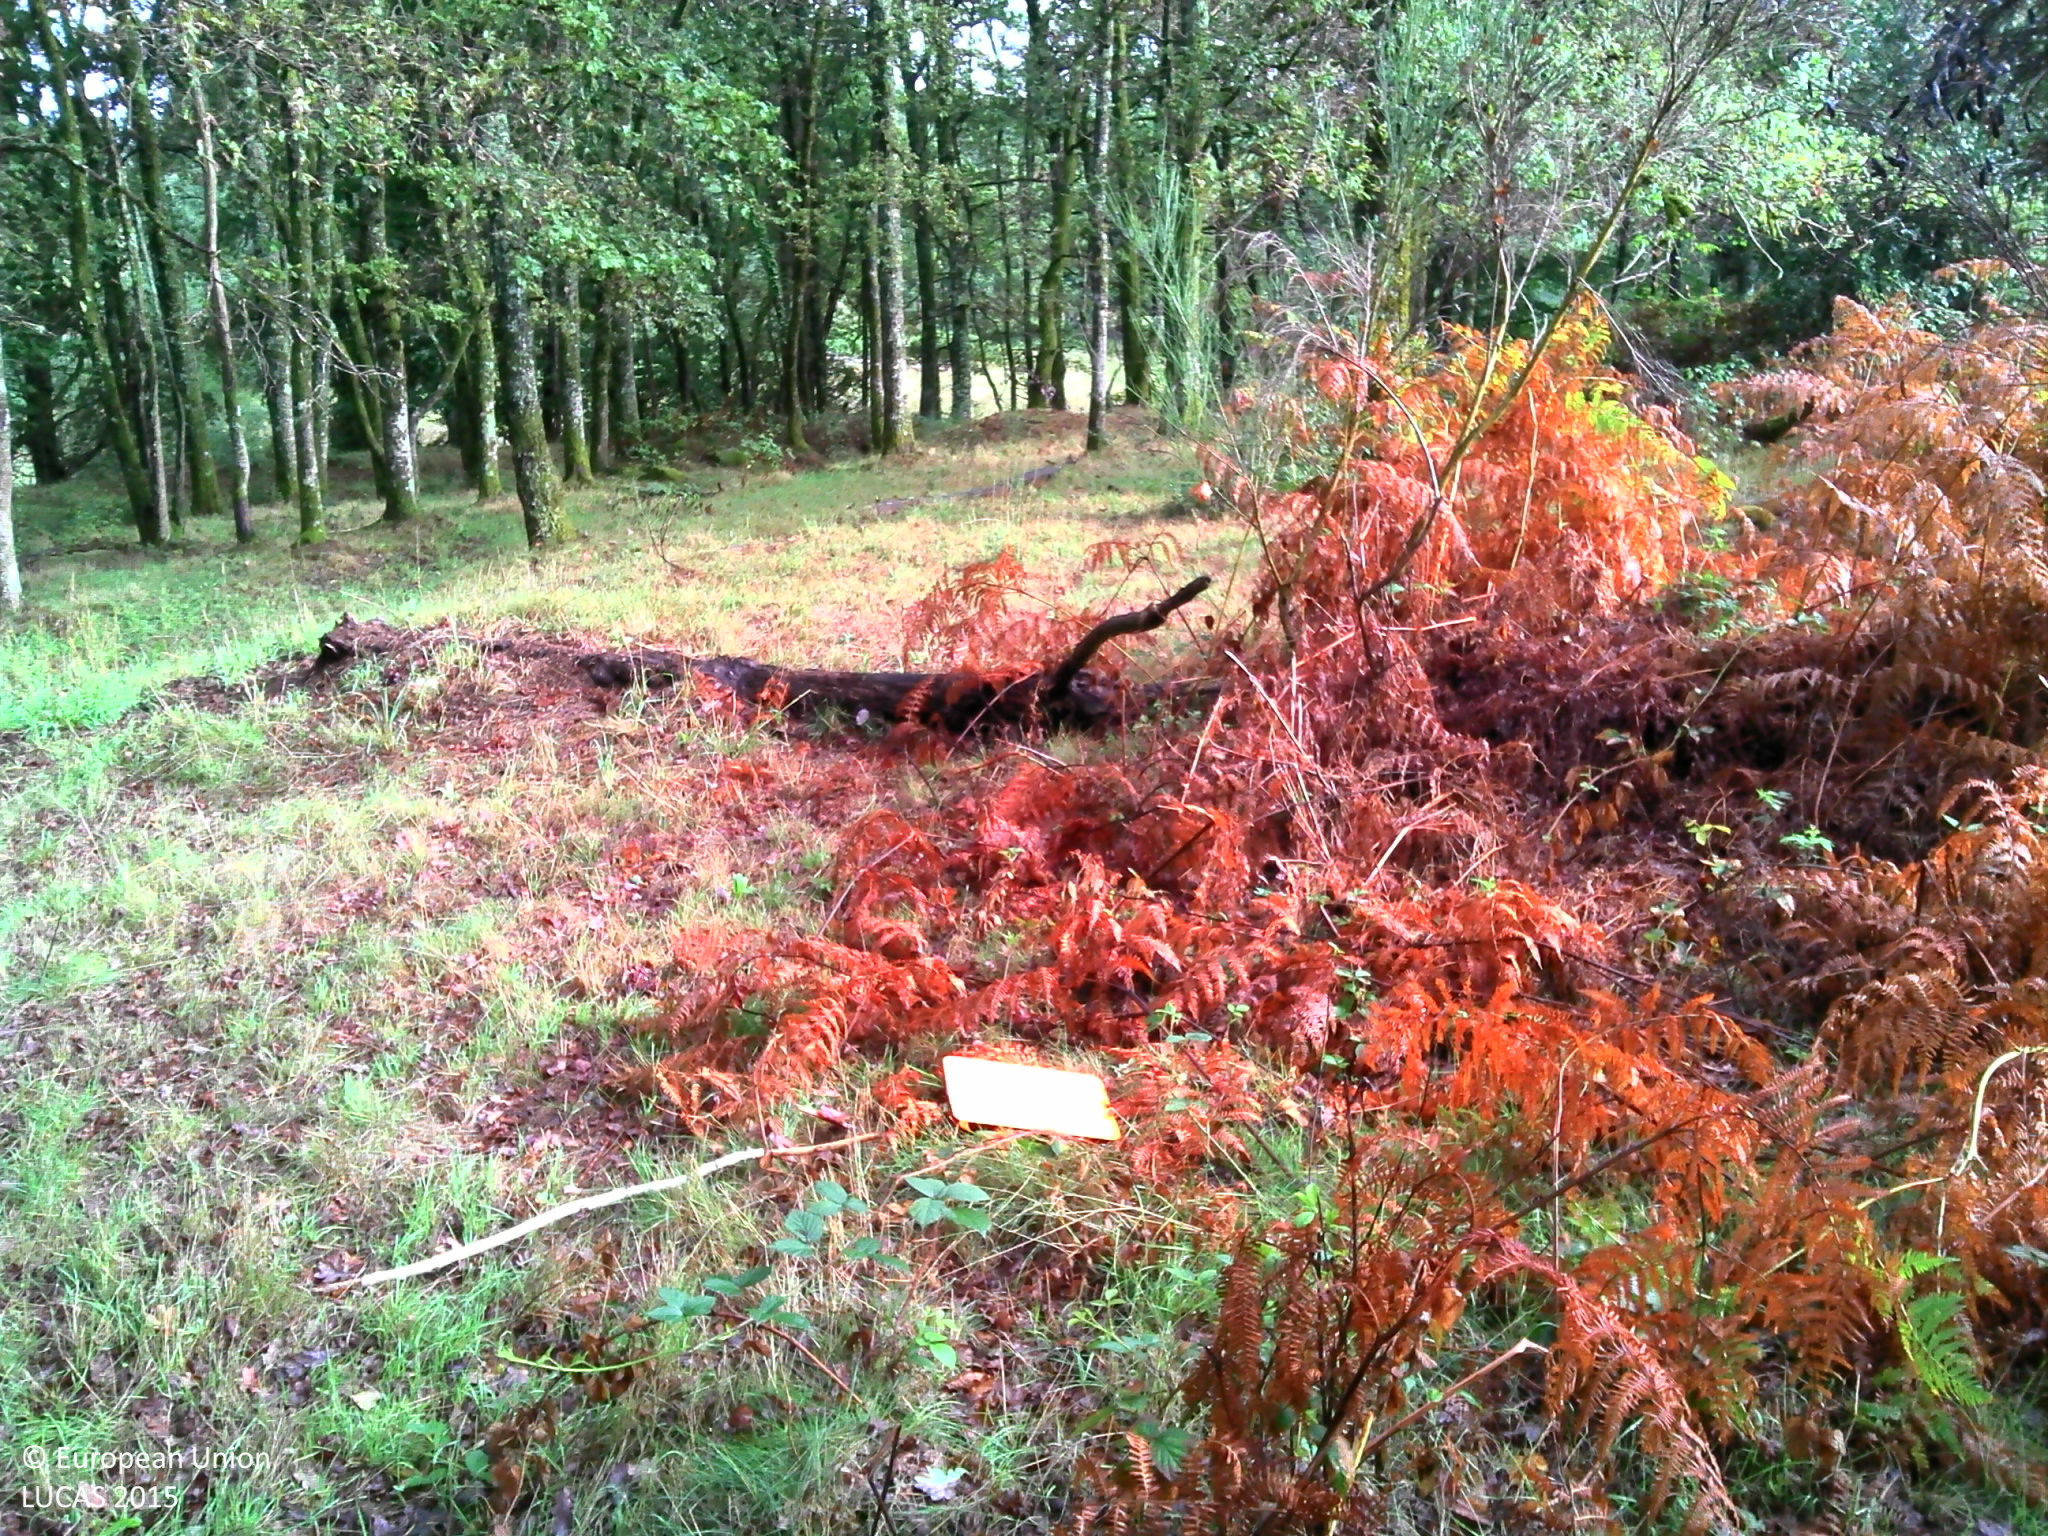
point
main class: Woodland
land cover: Broadleaved woodland
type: thermophilous deciduous forest
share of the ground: 50 - 75 %
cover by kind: herbaceous plants 70 %, broadleaved forest trees 30 %
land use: Forestry
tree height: > 5 m
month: August
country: FR
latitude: 45.5102
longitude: 1.7904
